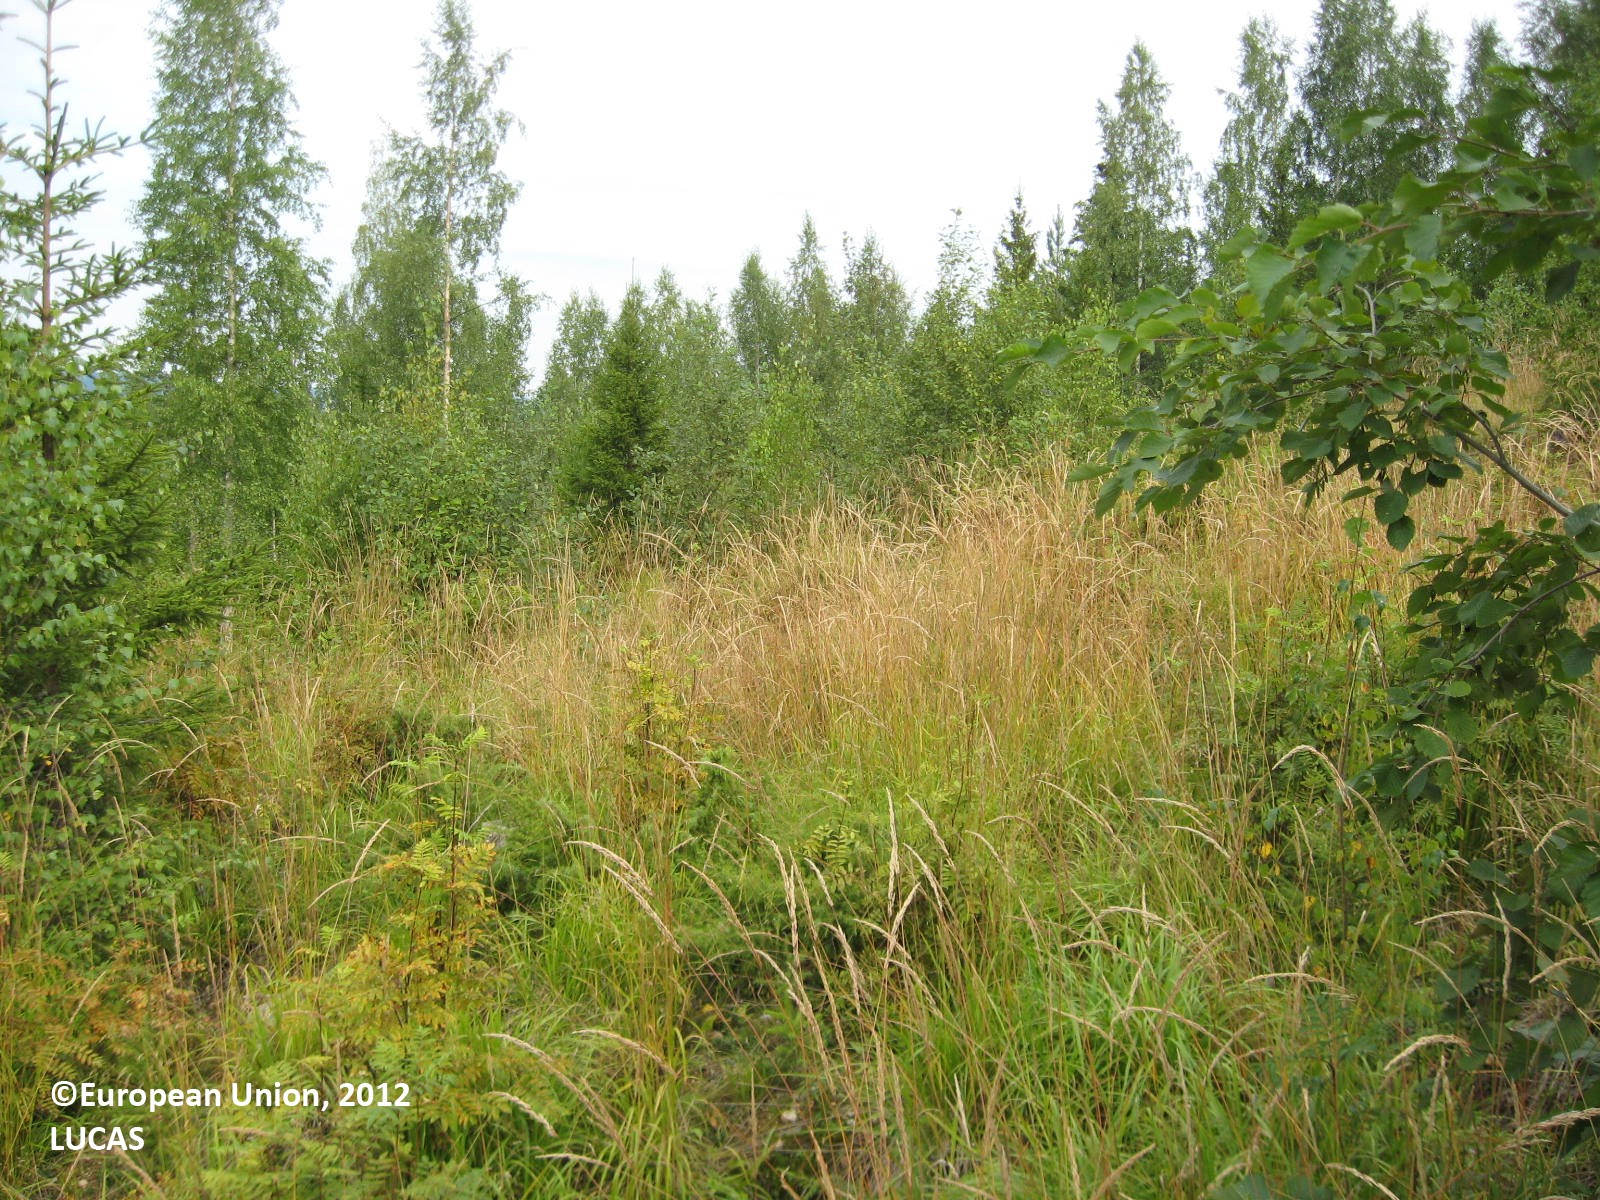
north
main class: Woodland
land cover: Other mixed woodland
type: boreal forest
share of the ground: 50 - 75 %
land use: Forestry
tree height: < 5 m
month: August
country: FI
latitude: 63.4439
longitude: 29.5361
